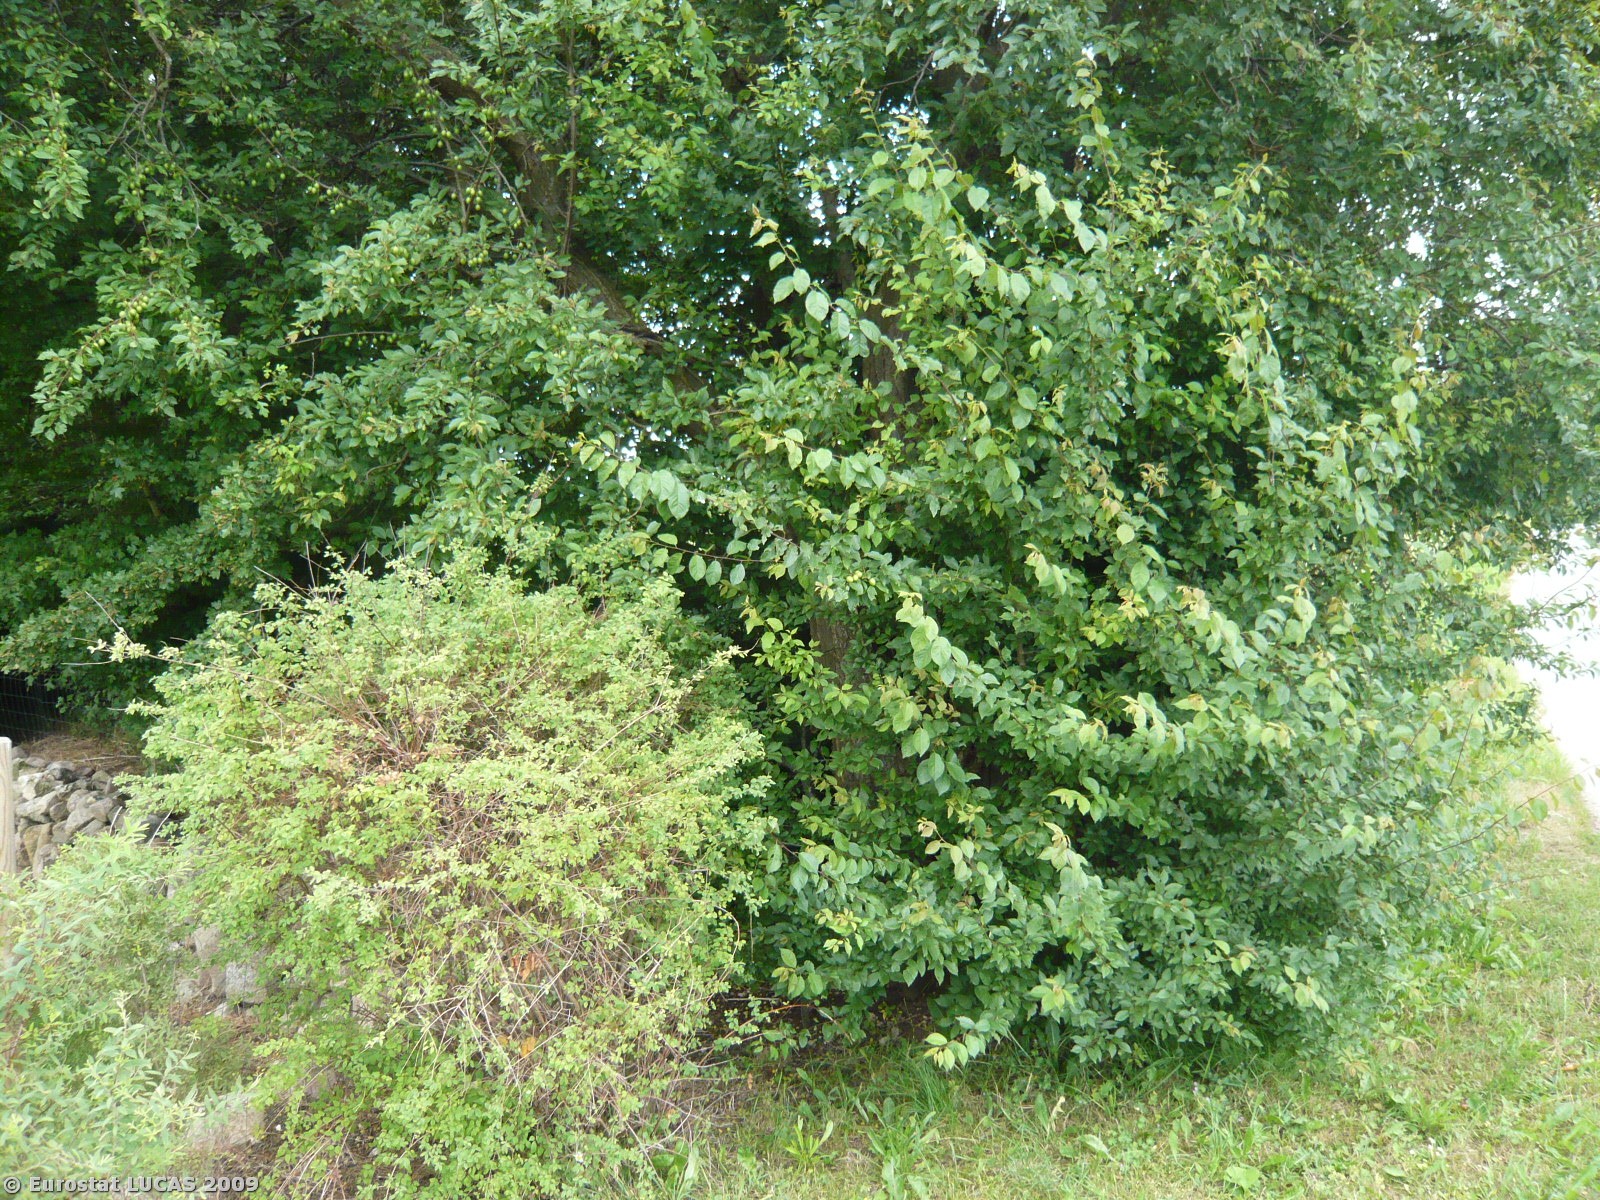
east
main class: Grassland
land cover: Grassland without tree/shrub cover
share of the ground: > 75 %
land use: Agriculture (excluding fallow land and kitchen gardens)
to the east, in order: Grassland without tree/shrub cover; Fences; Broadleaved woodland; Grassland without tree/shrub cover; Shrubland with sparse tree cover; Tracks; Grassland without tree/shrub cover; Shrubland with sparse tree cover; Tracks; Grassland without tree/shrub cover
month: July
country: DK
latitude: 55.4763
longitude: 11.6282
